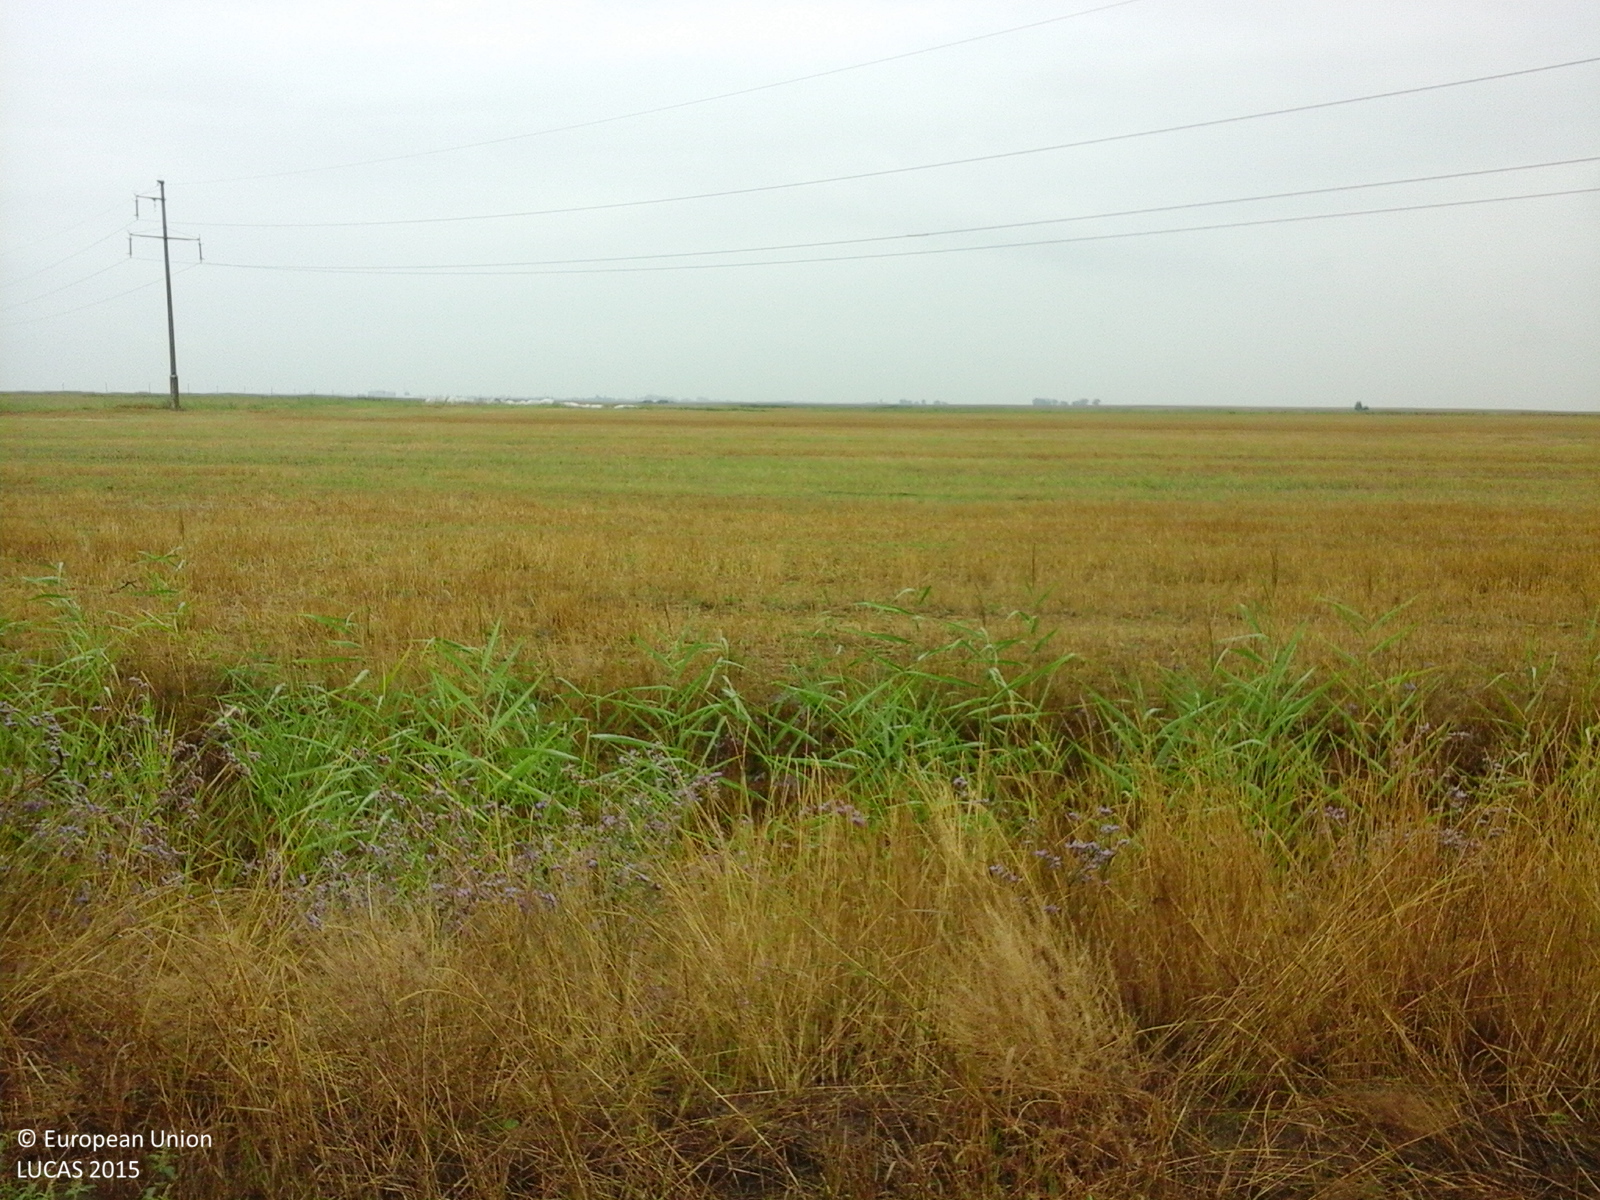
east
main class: Cropland
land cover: Common wheat
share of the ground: < 10 %
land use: Agriculture (excluding fallow land and kitchen gardens)
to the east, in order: Grass margins; Ditches and canals; Common wheat; Electric lines; Common wheat
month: August
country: RO
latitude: 45.6015
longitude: 20.9888
